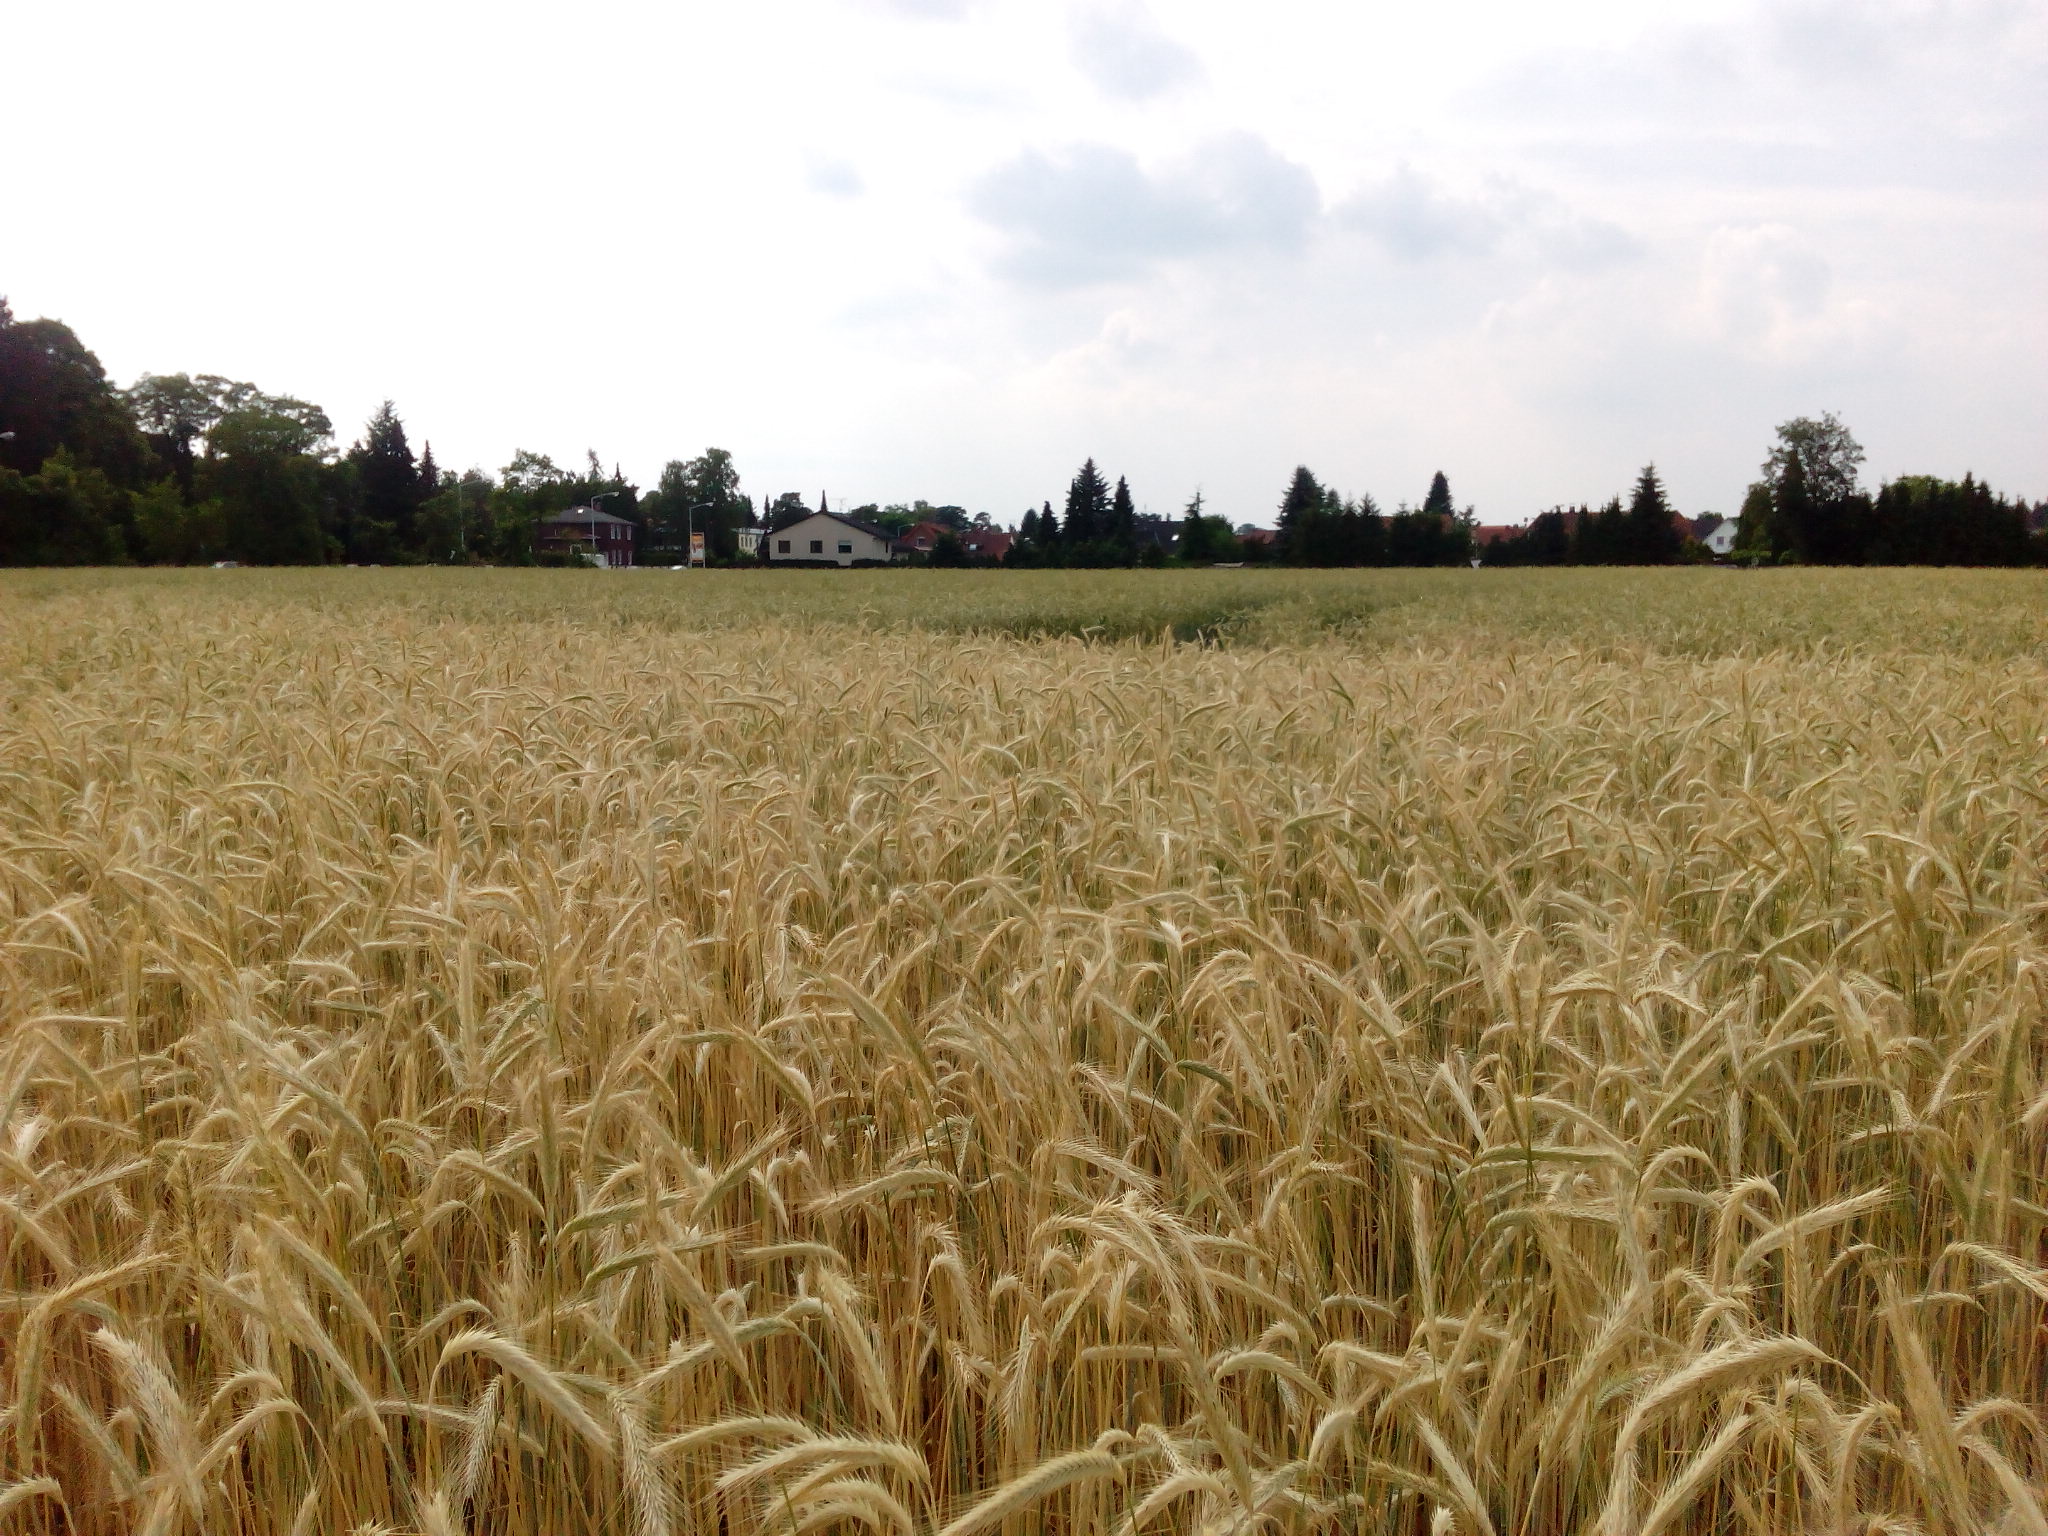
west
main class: Cropland
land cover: Rye
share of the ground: > 75 %
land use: Agriculture (excluding fallow land and kitchen gardens)
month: June
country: DE
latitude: 52.6470
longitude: 9.8670
